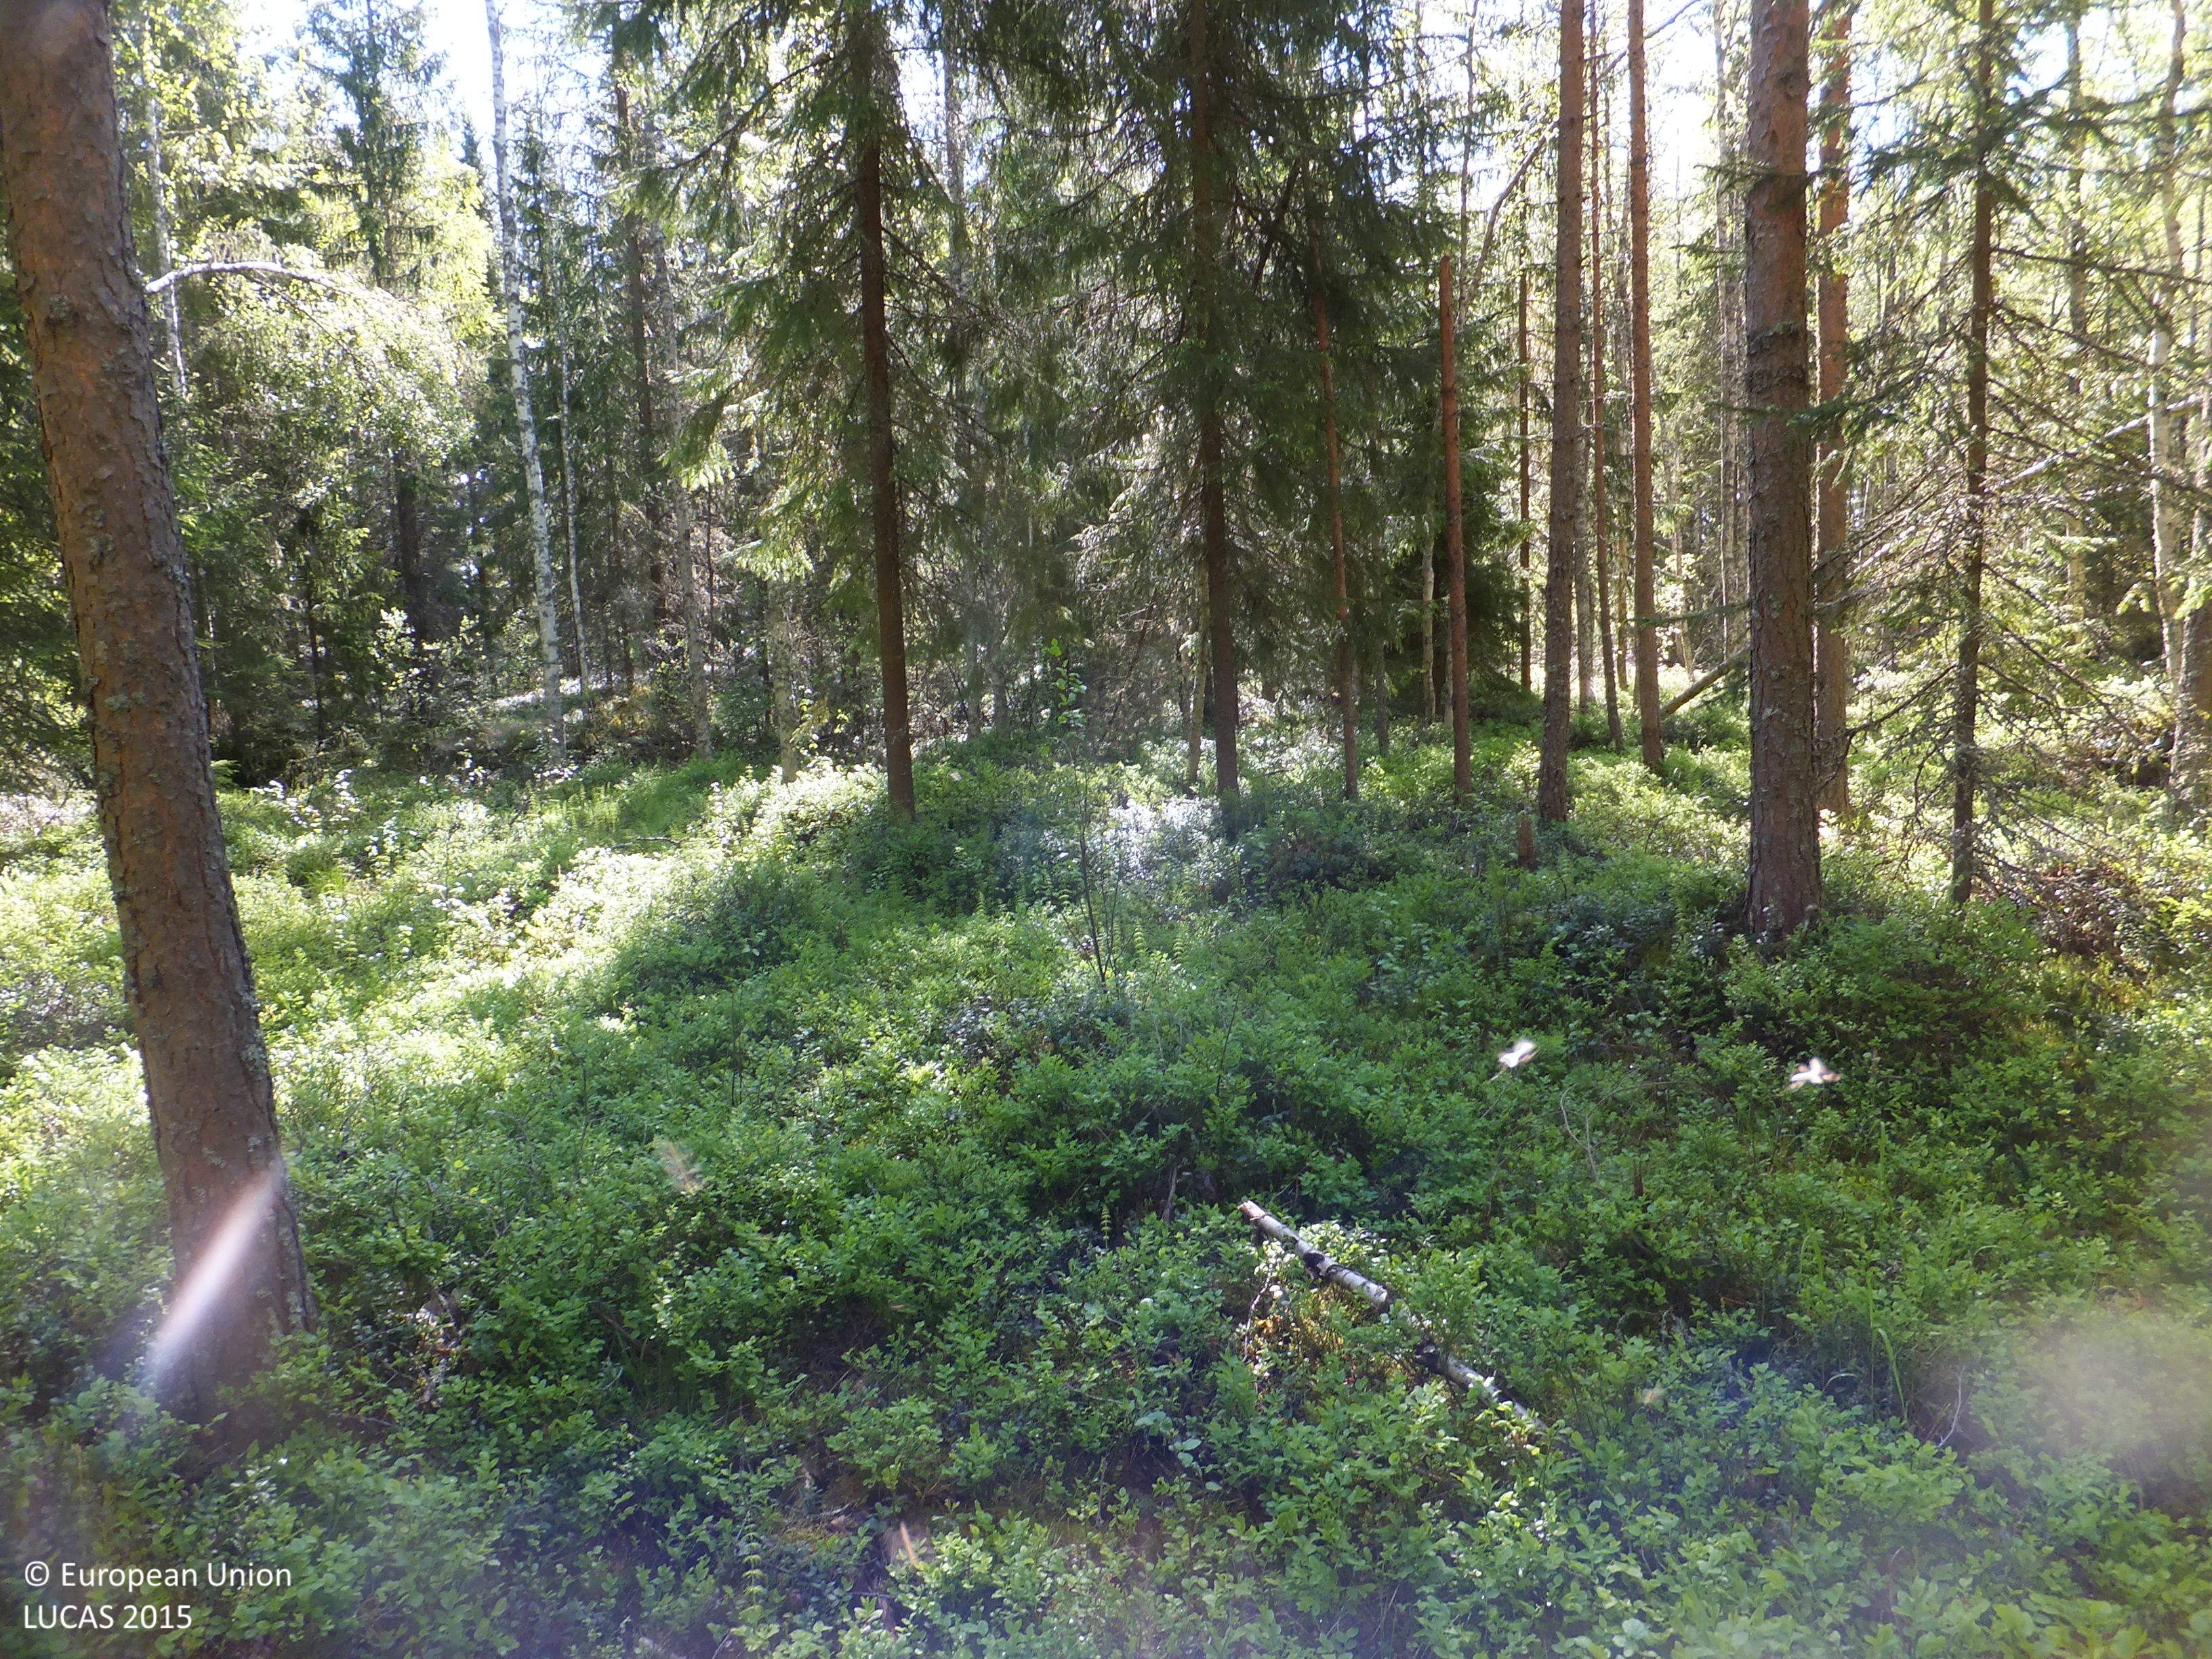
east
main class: Woodland
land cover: Other mixed woodland
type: boreal forest
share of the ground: > 75 %
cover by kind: coniferous forest trees 45 %, broadleaved forest trees 30 %, shrubs 20 %, lichens and mosses 5 %
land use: Forestry
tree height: > 5 m
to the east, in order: Other mixed woodland; Pine dominated coniferous woodland; Tracks; Spruce dominated coniferous woodland; Ditches and canals; Grass margins; Temporary grasslands
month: June
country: FI
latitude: 63.6125
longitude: 22.8981
